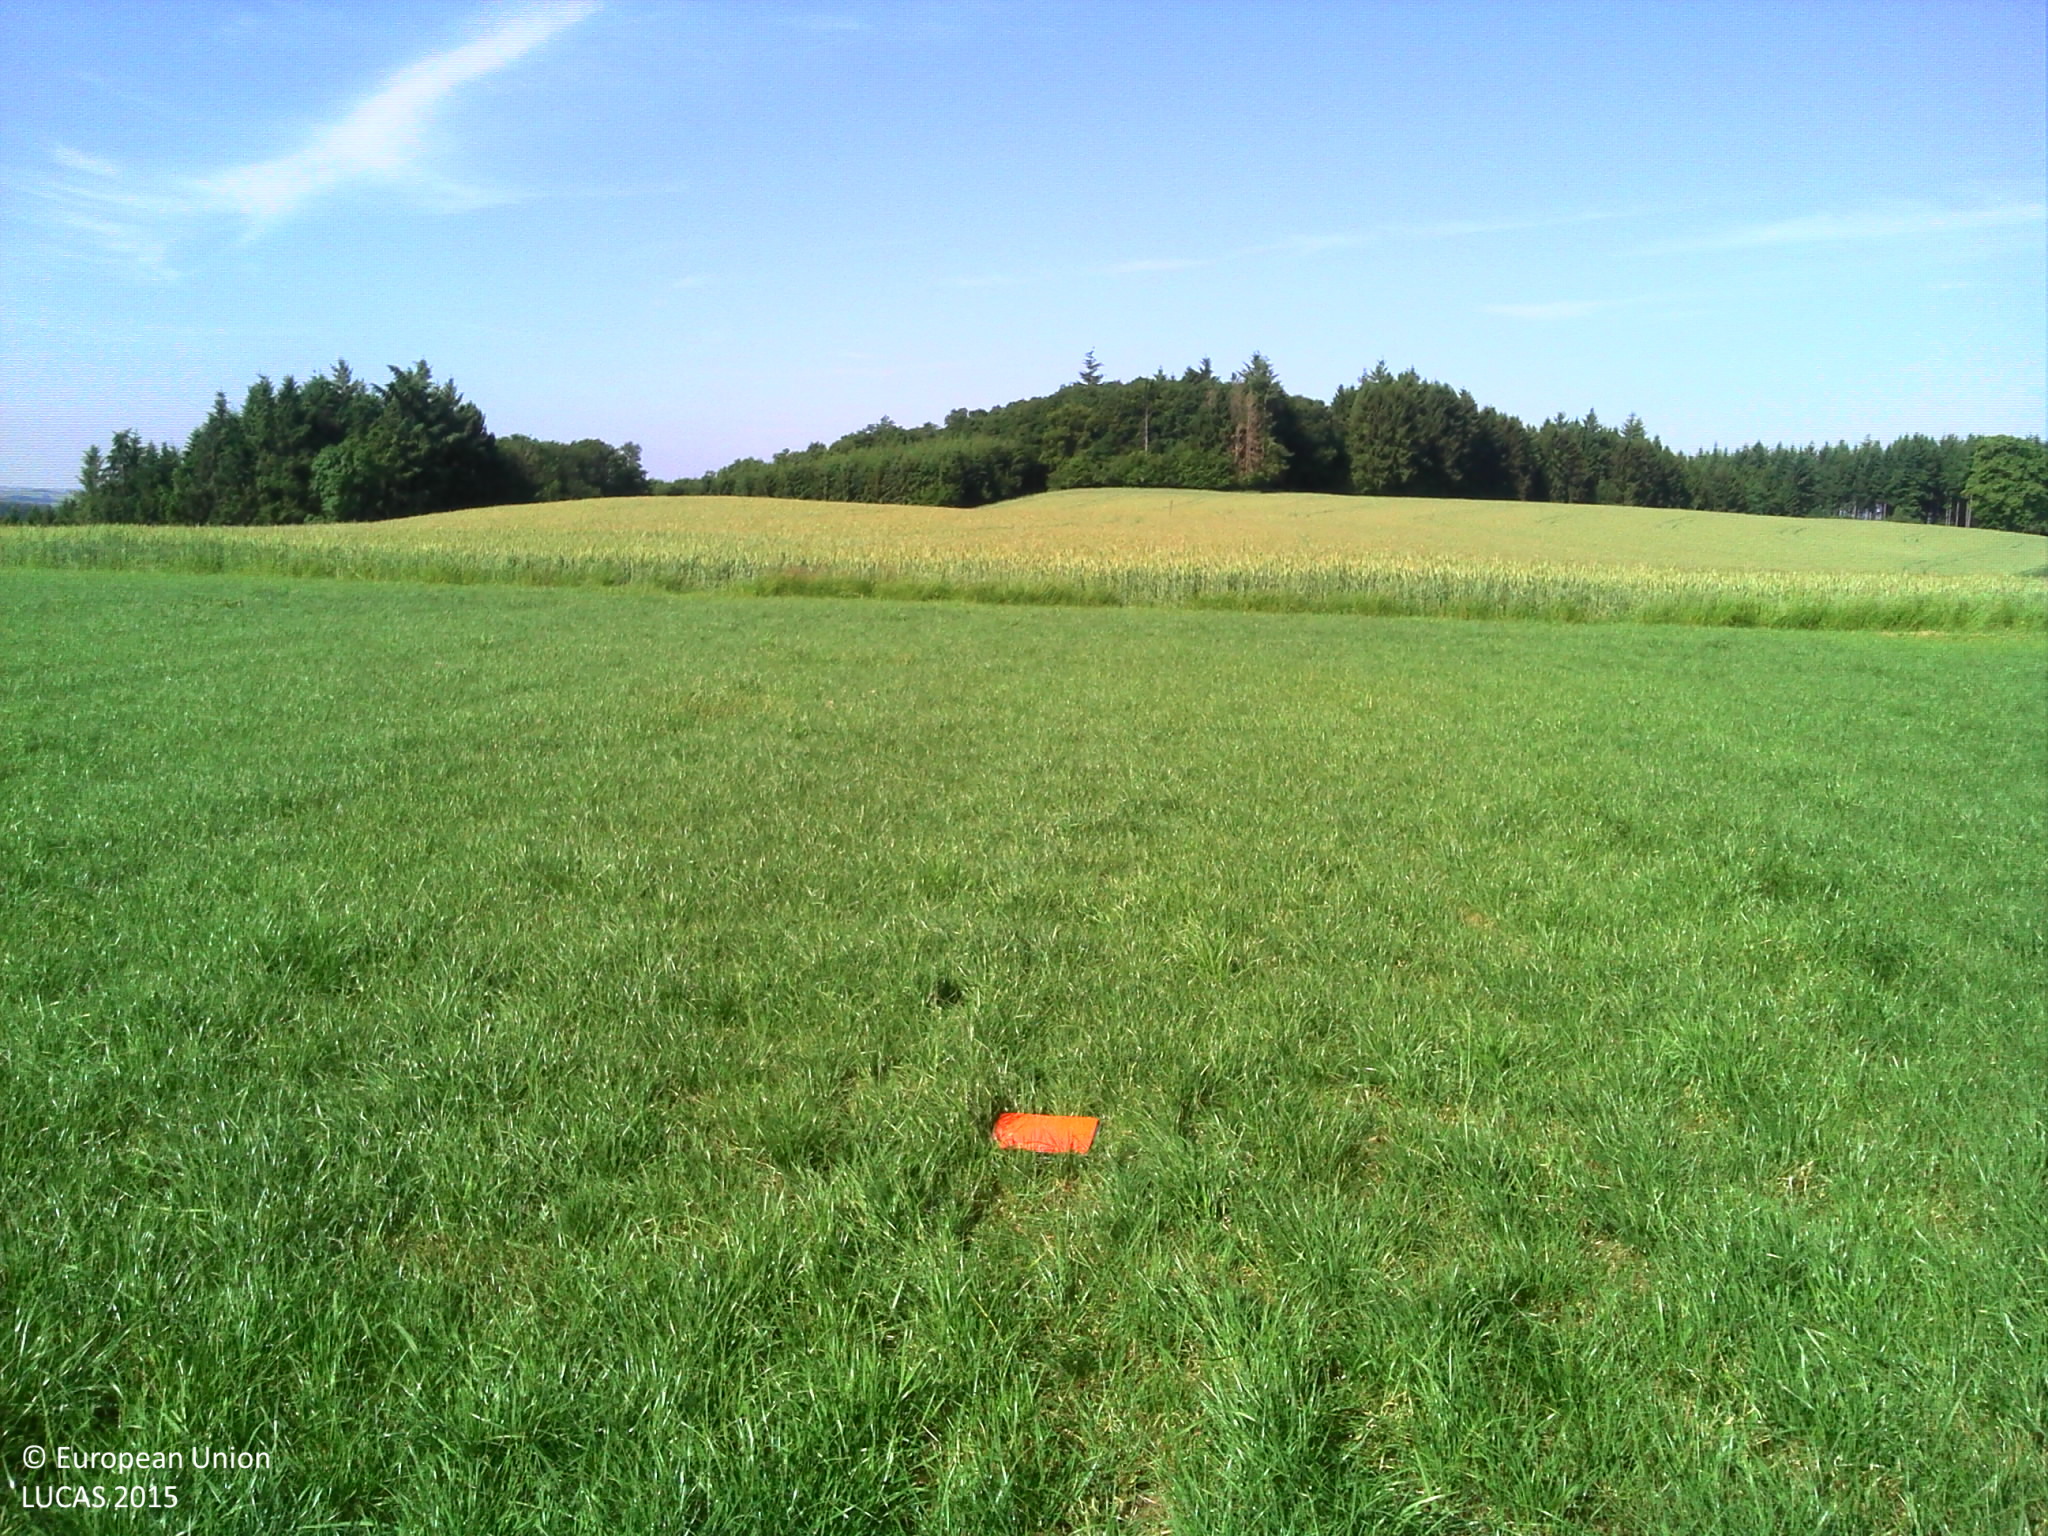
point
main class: Cropland
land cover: Temporary grasslands
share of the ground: > 75 %
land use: Agriculture (excluding fallow land and kitchen gardens)
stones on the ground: 10 - 25 %
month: June
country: LU
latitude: 50.0078
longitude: 6.0504
